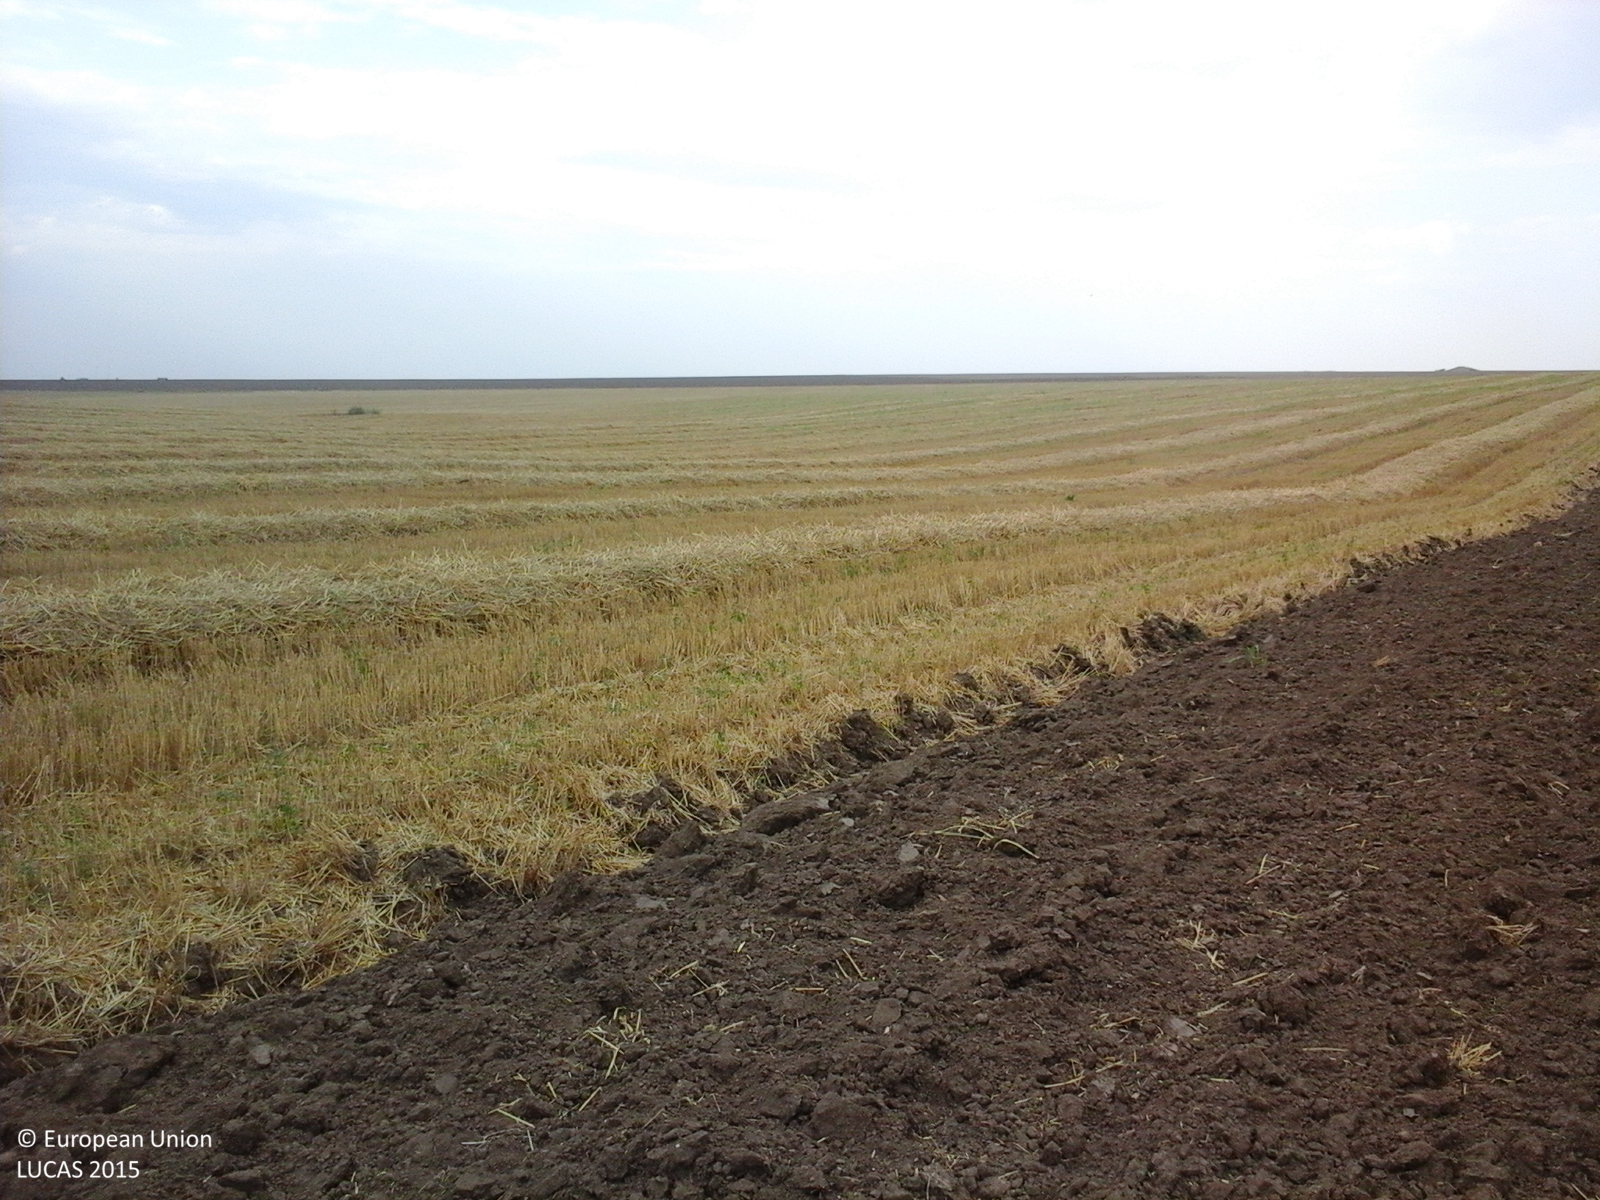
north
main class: Cropland
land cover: Maize
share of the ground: > 75 %
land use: Agriculture (excluding fallow land and kitchen gardens)
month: August
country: RO
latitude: 44.2150
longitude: 28.3256
